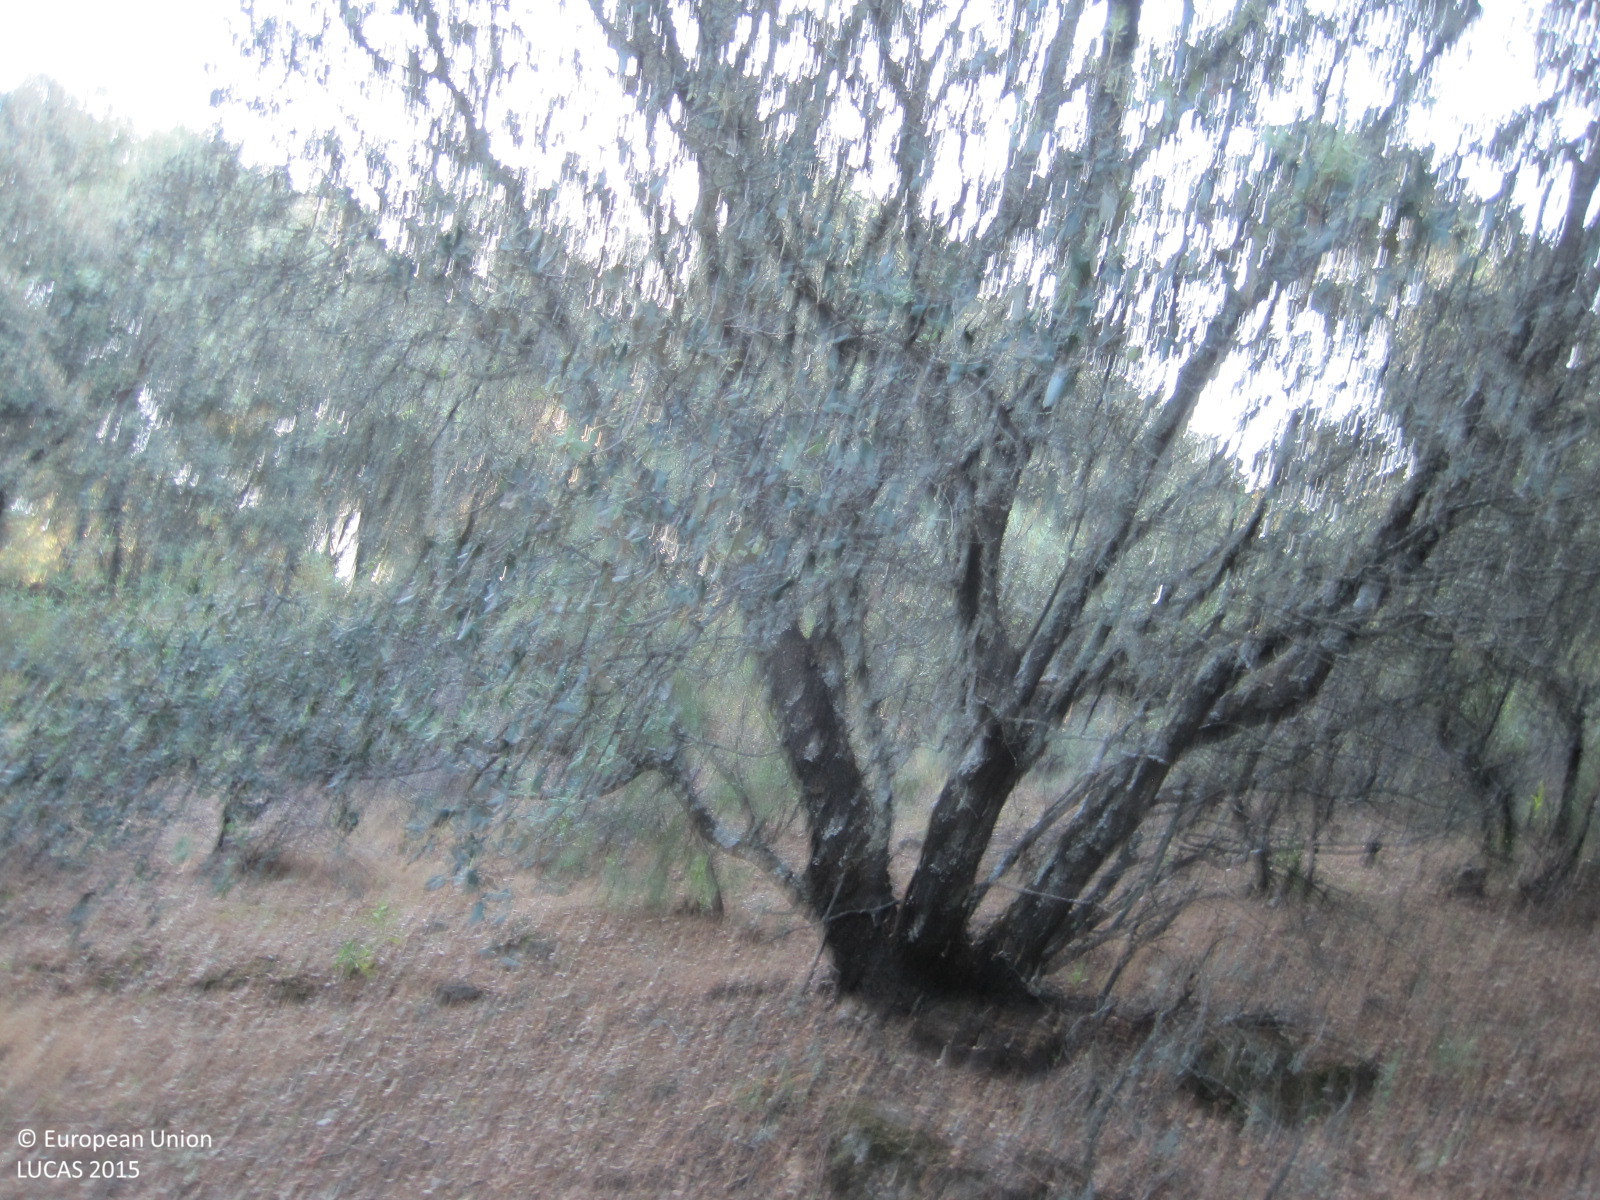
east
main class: Woodland
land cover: Broadleaved woodland
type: broadleaved evergreen forest
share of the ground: > 75 %
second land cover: Grassland without tree/shrub cover
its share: 10 - 25 %
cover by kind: broadleaved forest trees 70 %, herbaceous plants 15 %, unconsolidated bare surface 15 %
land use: Forestry
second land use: Agriculture (excluding fallow land and kitchen gardens)
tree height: < 5 m
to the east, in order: Broadleaved woodland; Grassland without tree/shrub cover; Dry stone walls; Grass margins; Tracks; Grass margins; Dry stone walls; Pine dominated mixed woodland; Grassland without tree/shrub cover; Dry stone walls; Shrubland with sparse tree cover; Grass margins; Tracks
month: May
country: ES
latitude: 40.2778
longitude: -4.7883
